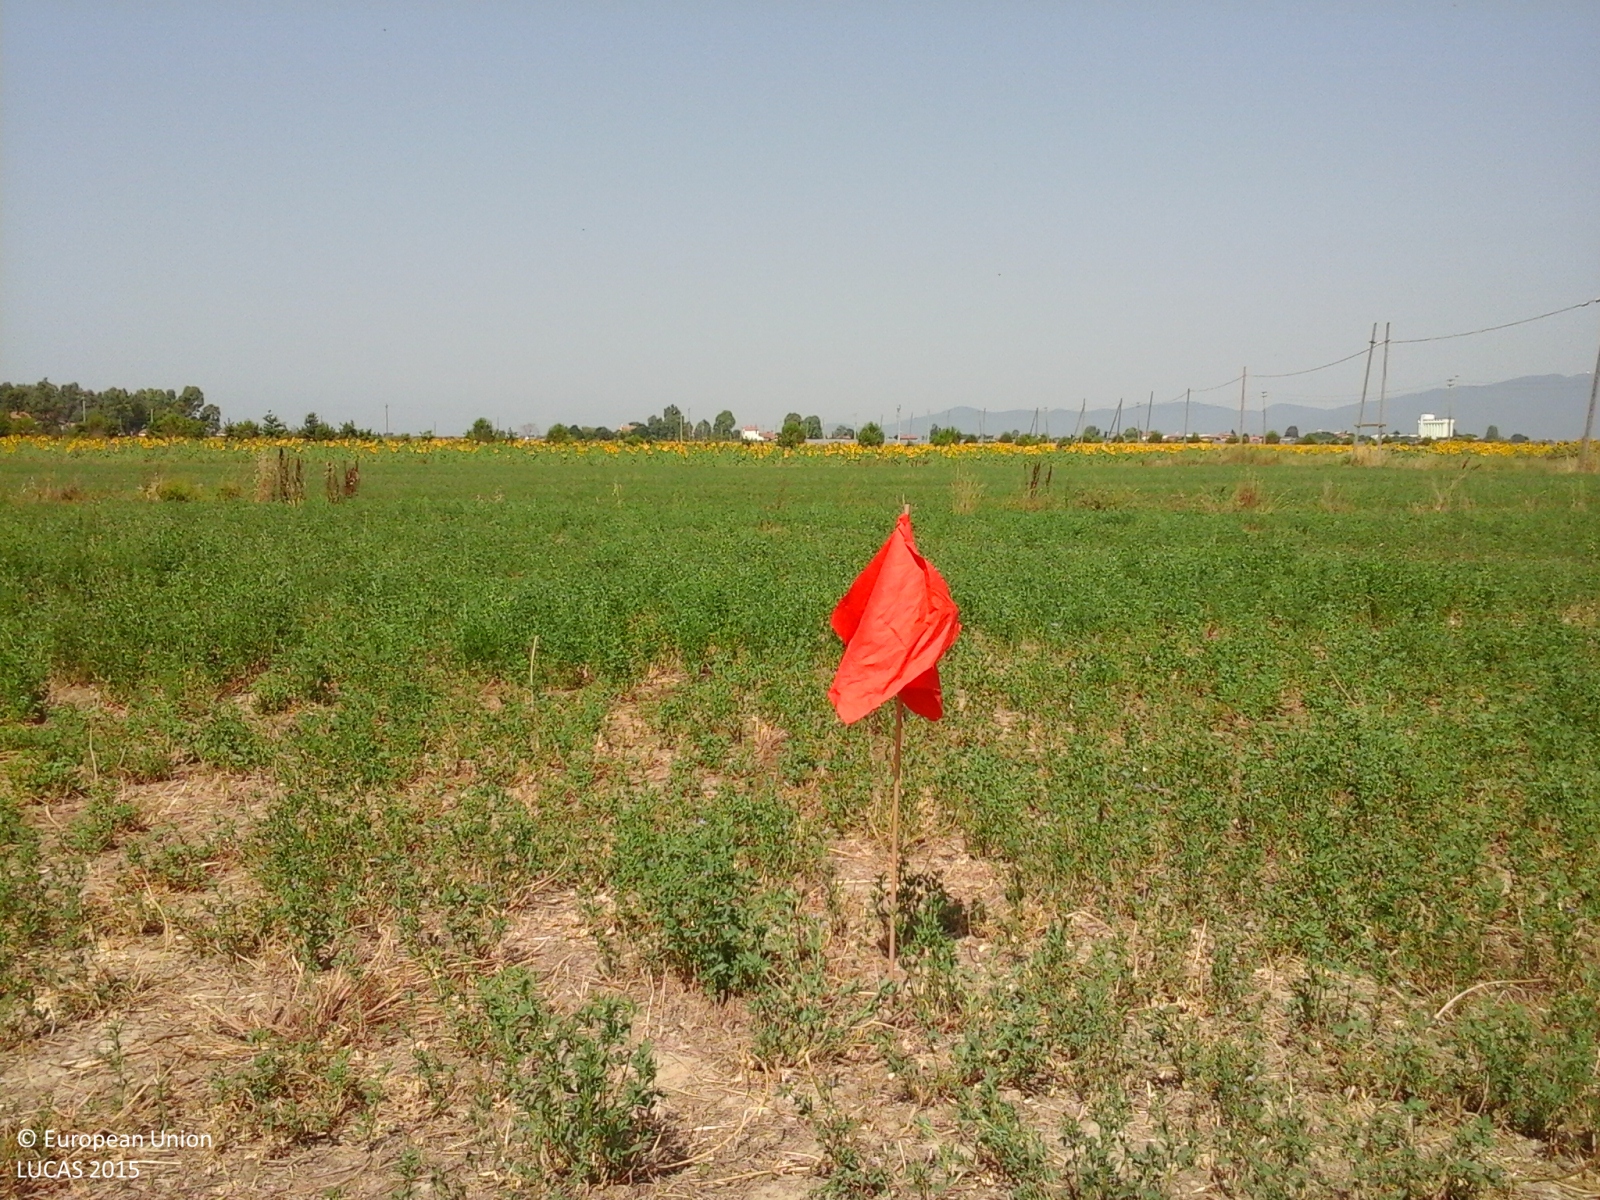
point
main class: Cropland
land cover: Lucerne
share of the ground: > 75 %
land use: Agriculture (excluding fallow land and kitchen gardens)
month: July
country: IT
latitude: 42.7571
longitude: 11.0352
